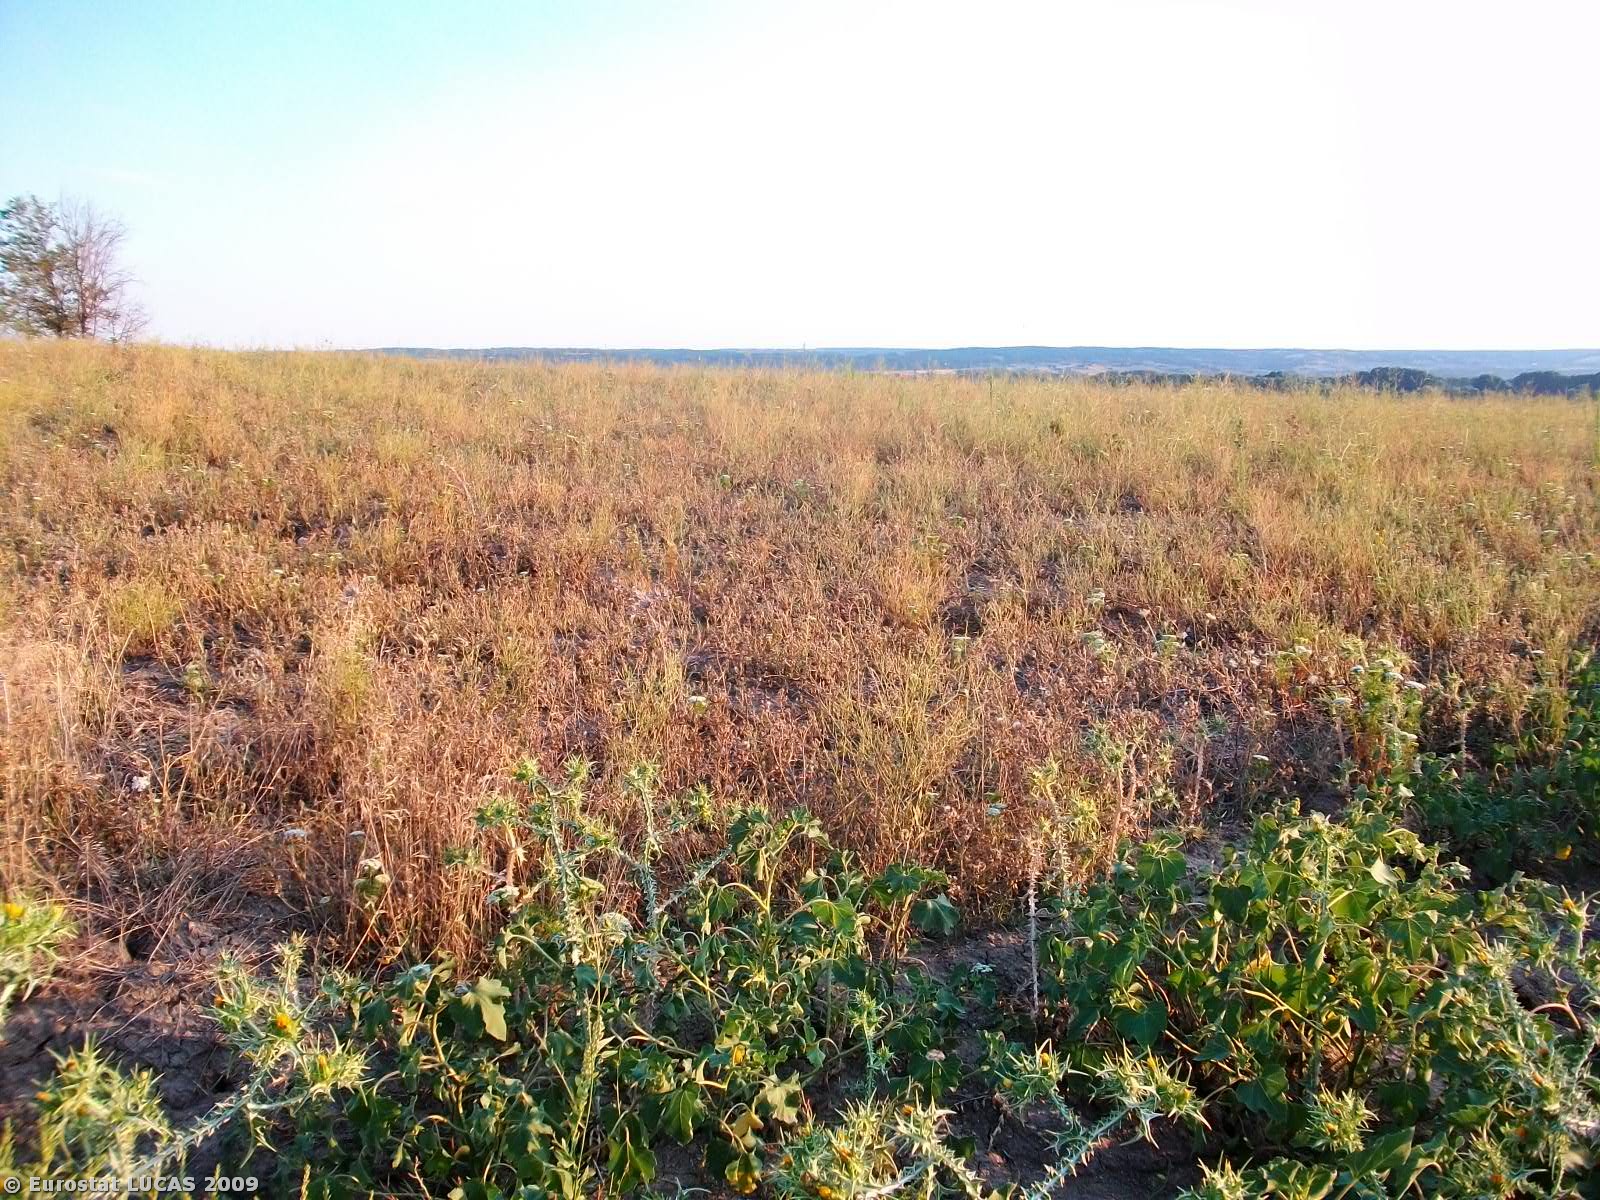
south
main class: Cropland
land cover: Cotton
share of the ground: 50 - 75 %
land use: Agriculture (excluding fallow land and kitchen gardens)
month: August
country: GR
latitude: 41.3944
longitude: 26.4250
